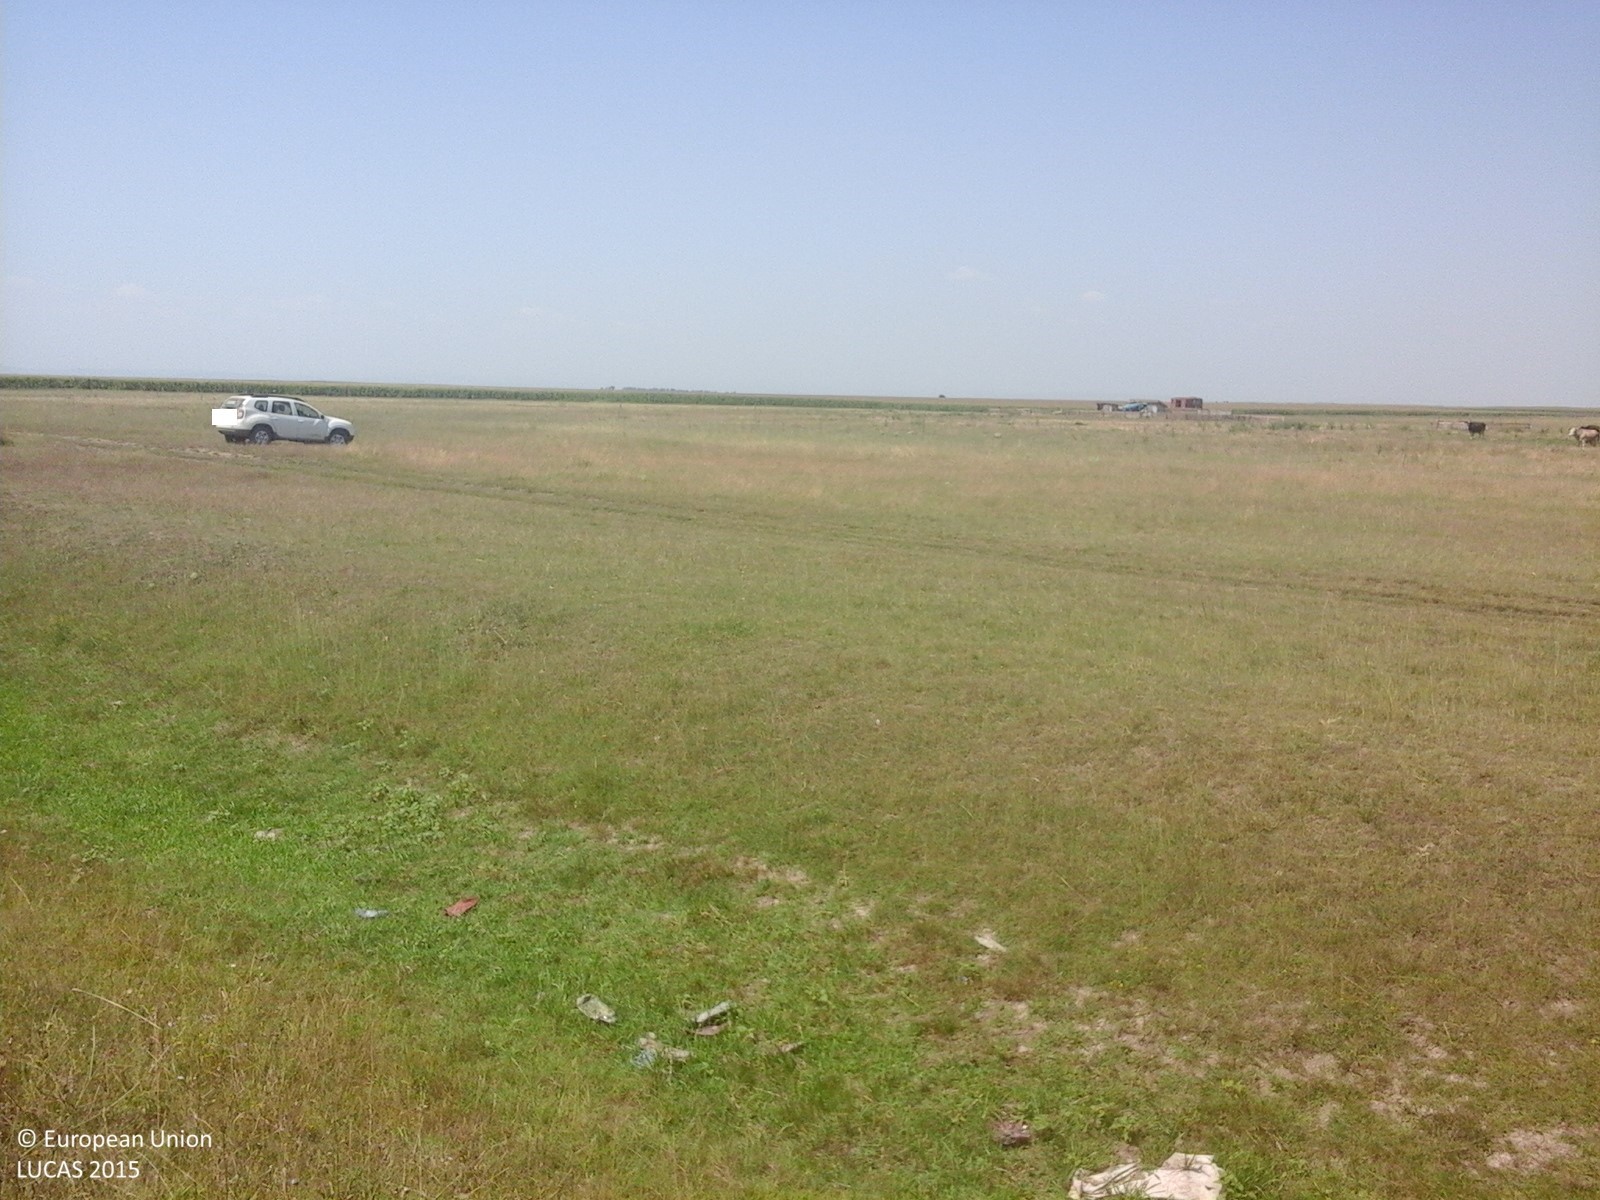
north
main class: Cropland
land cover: Maize
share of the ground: > 75 %
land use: Agriculture (excluding fallow land and kitchen gardens)
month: July
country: RO
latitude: 44.9393
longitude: 26.8964
